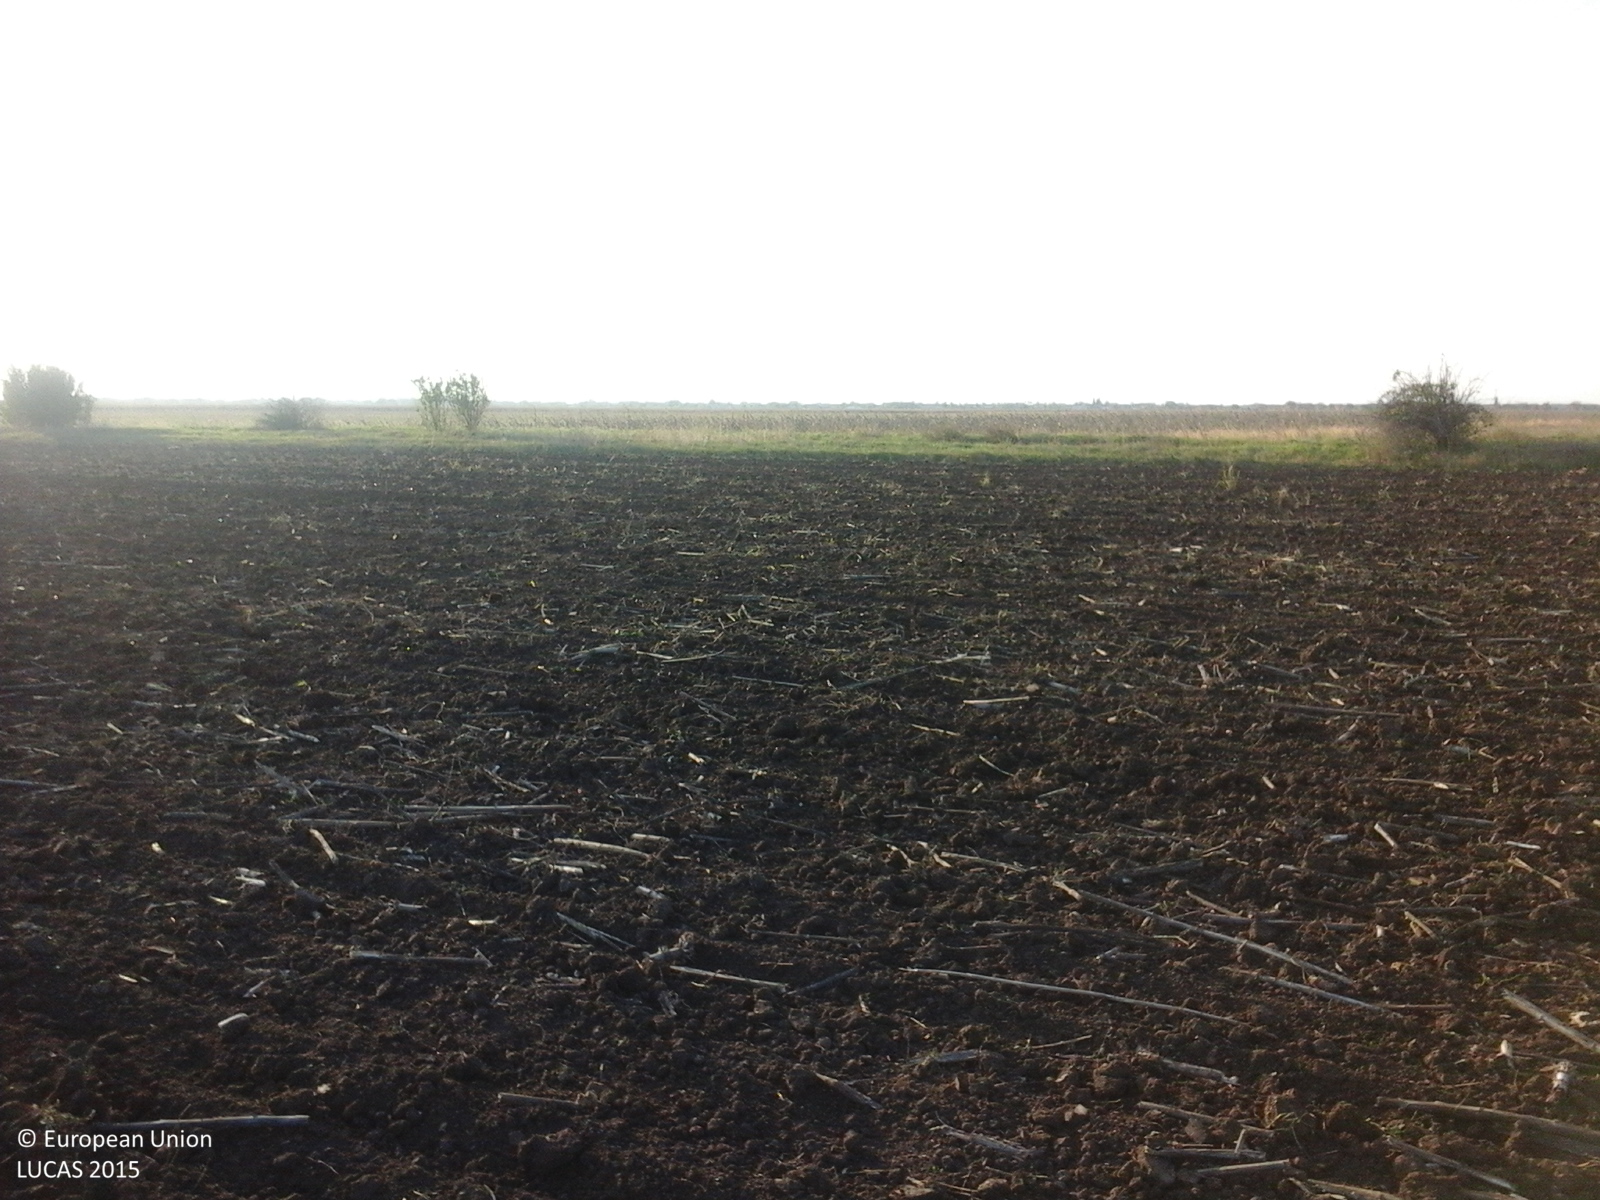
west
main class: Cropland
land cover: Sunflower
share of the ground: < 10 %
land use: Agriculture (excluding fallow land and kitchen gardens)
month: October
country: RO
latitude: 45.1574
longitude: 26.9120
